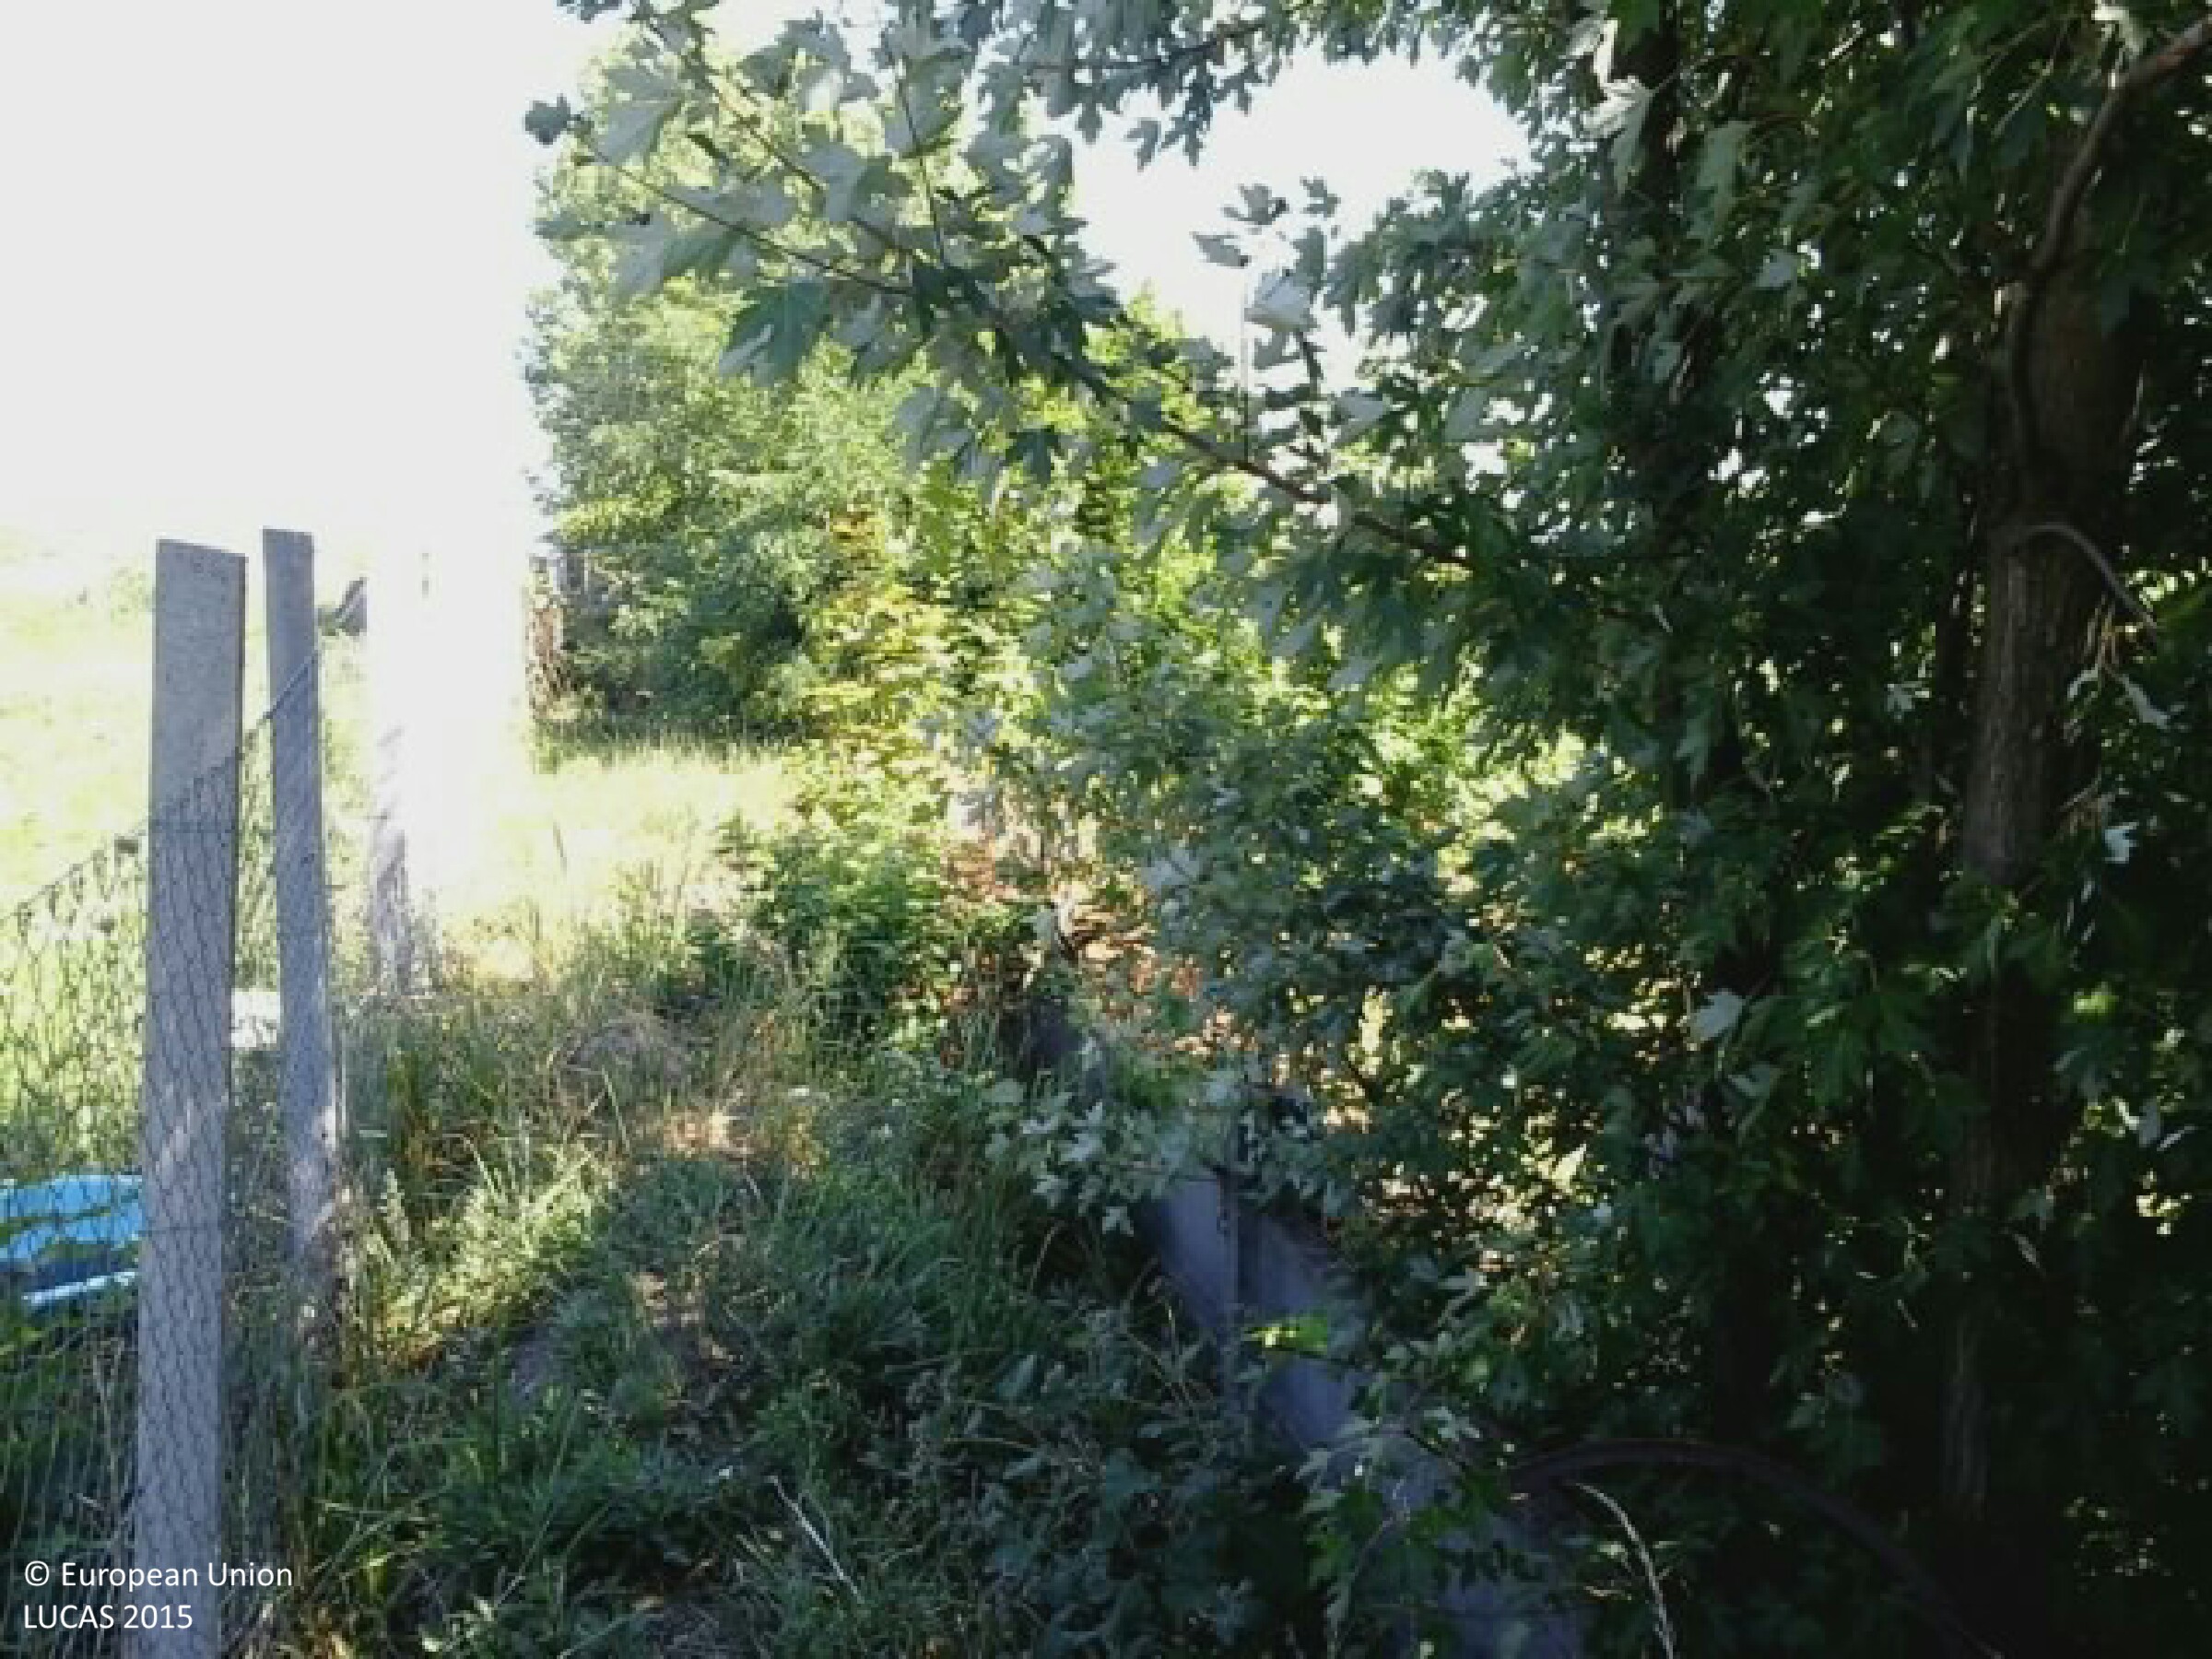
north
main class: Grassland
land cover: Spontaneously vegetated surfaces
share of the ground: > 75 %
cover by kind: herbaceous plants 100 %
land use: Agriculture (excluding fallow land and kitchen gardens)
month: July
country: HU
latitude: 48.2620
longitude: 20.7189
